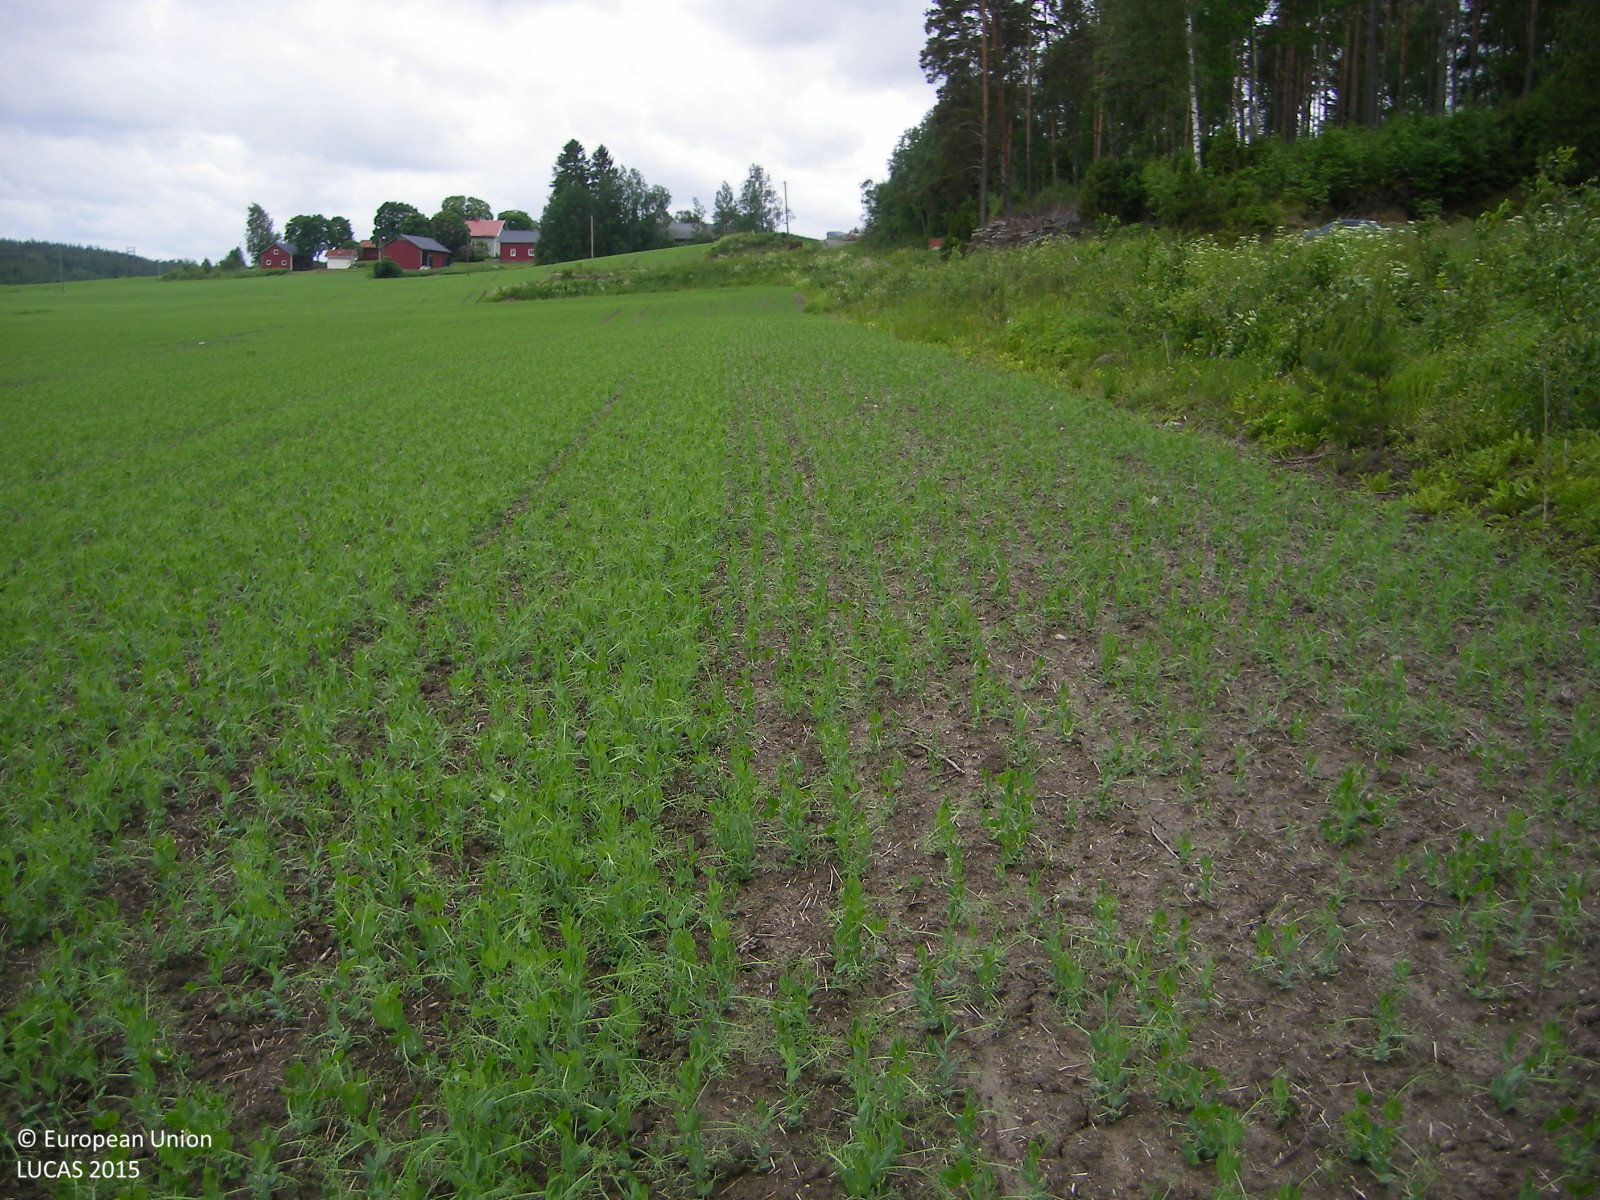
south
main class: Cropland
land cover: Dry pulses
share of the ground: > 75 %
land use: Agriculture (excluding fallow land and kitchen gardens)
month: June
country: FI
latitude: 60.2644
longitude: 23.2604
